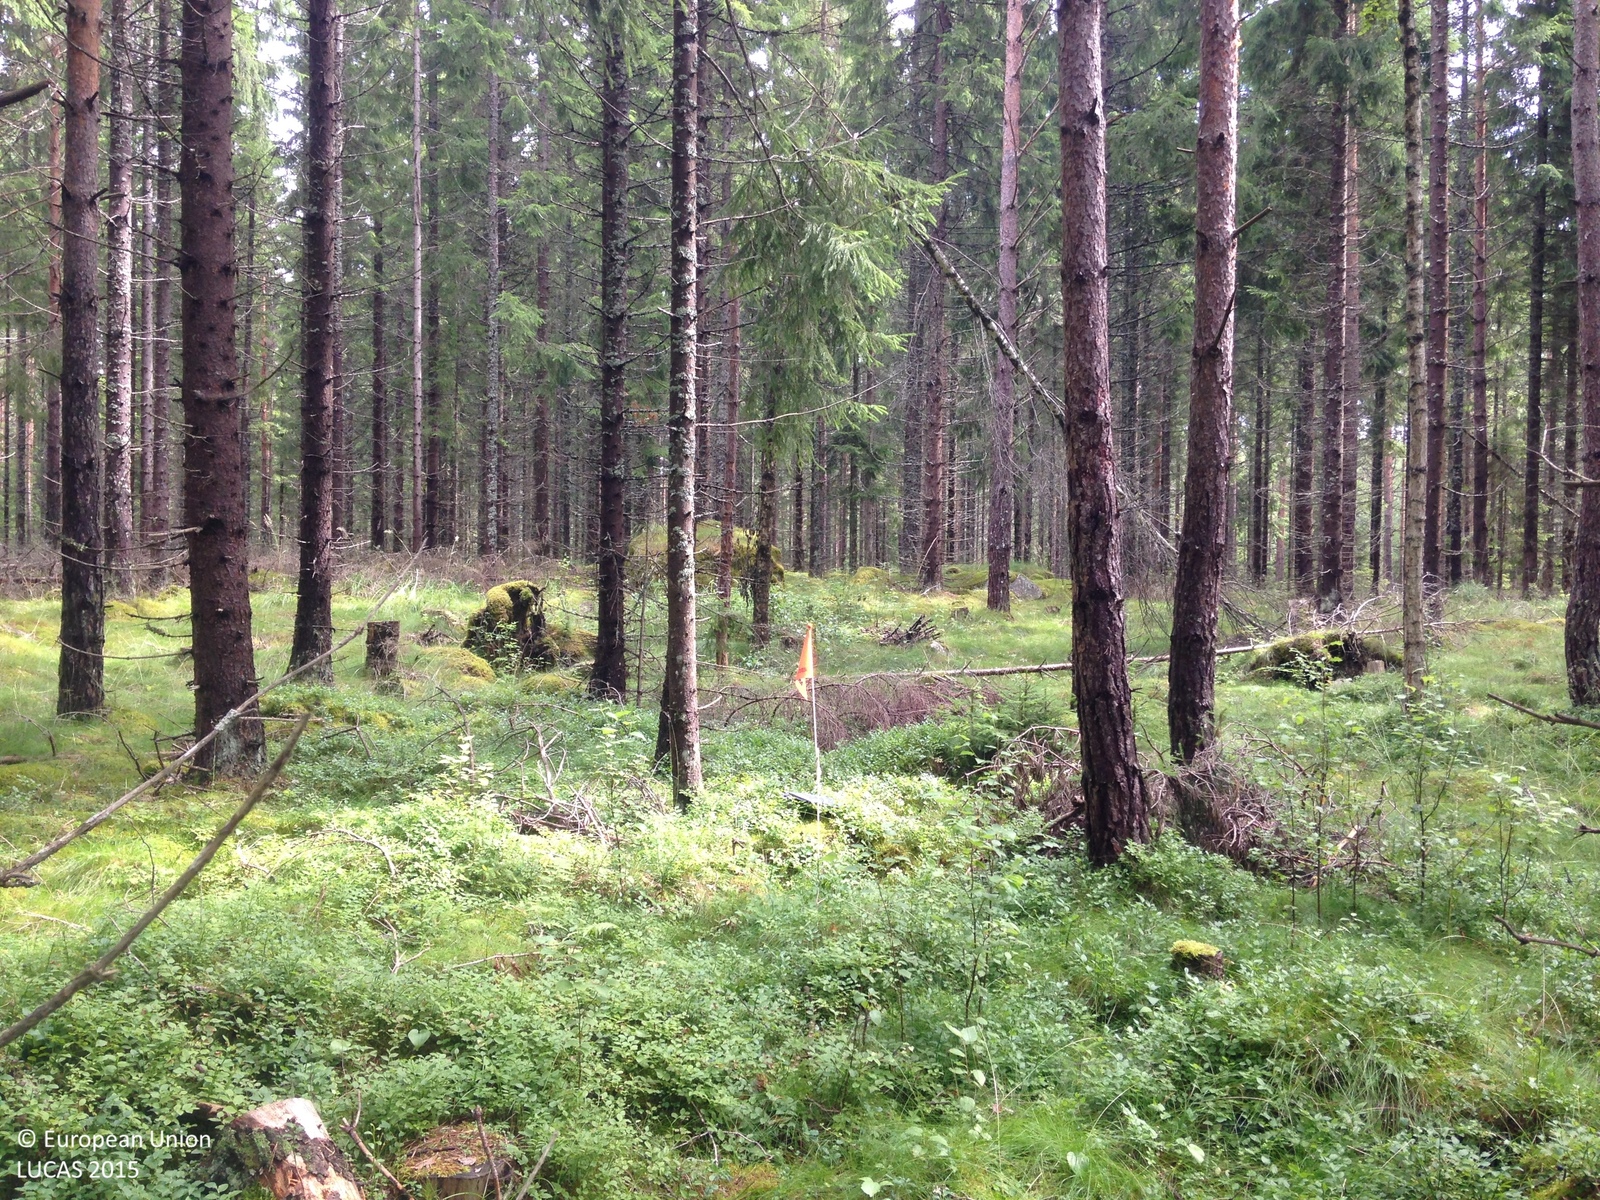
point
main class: Woodland
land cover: Other coniferous woodland
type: boreal forest
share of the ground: 25 - 50 %
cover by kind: coniferous forest trees 40 %, herbaceous plants 35 %, lichens and mosses 20 %, broadleaved forest trees 5 %
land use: Forestry
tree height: > 5 m
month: July
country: SE
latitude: 58.9946
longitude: 14.3957
